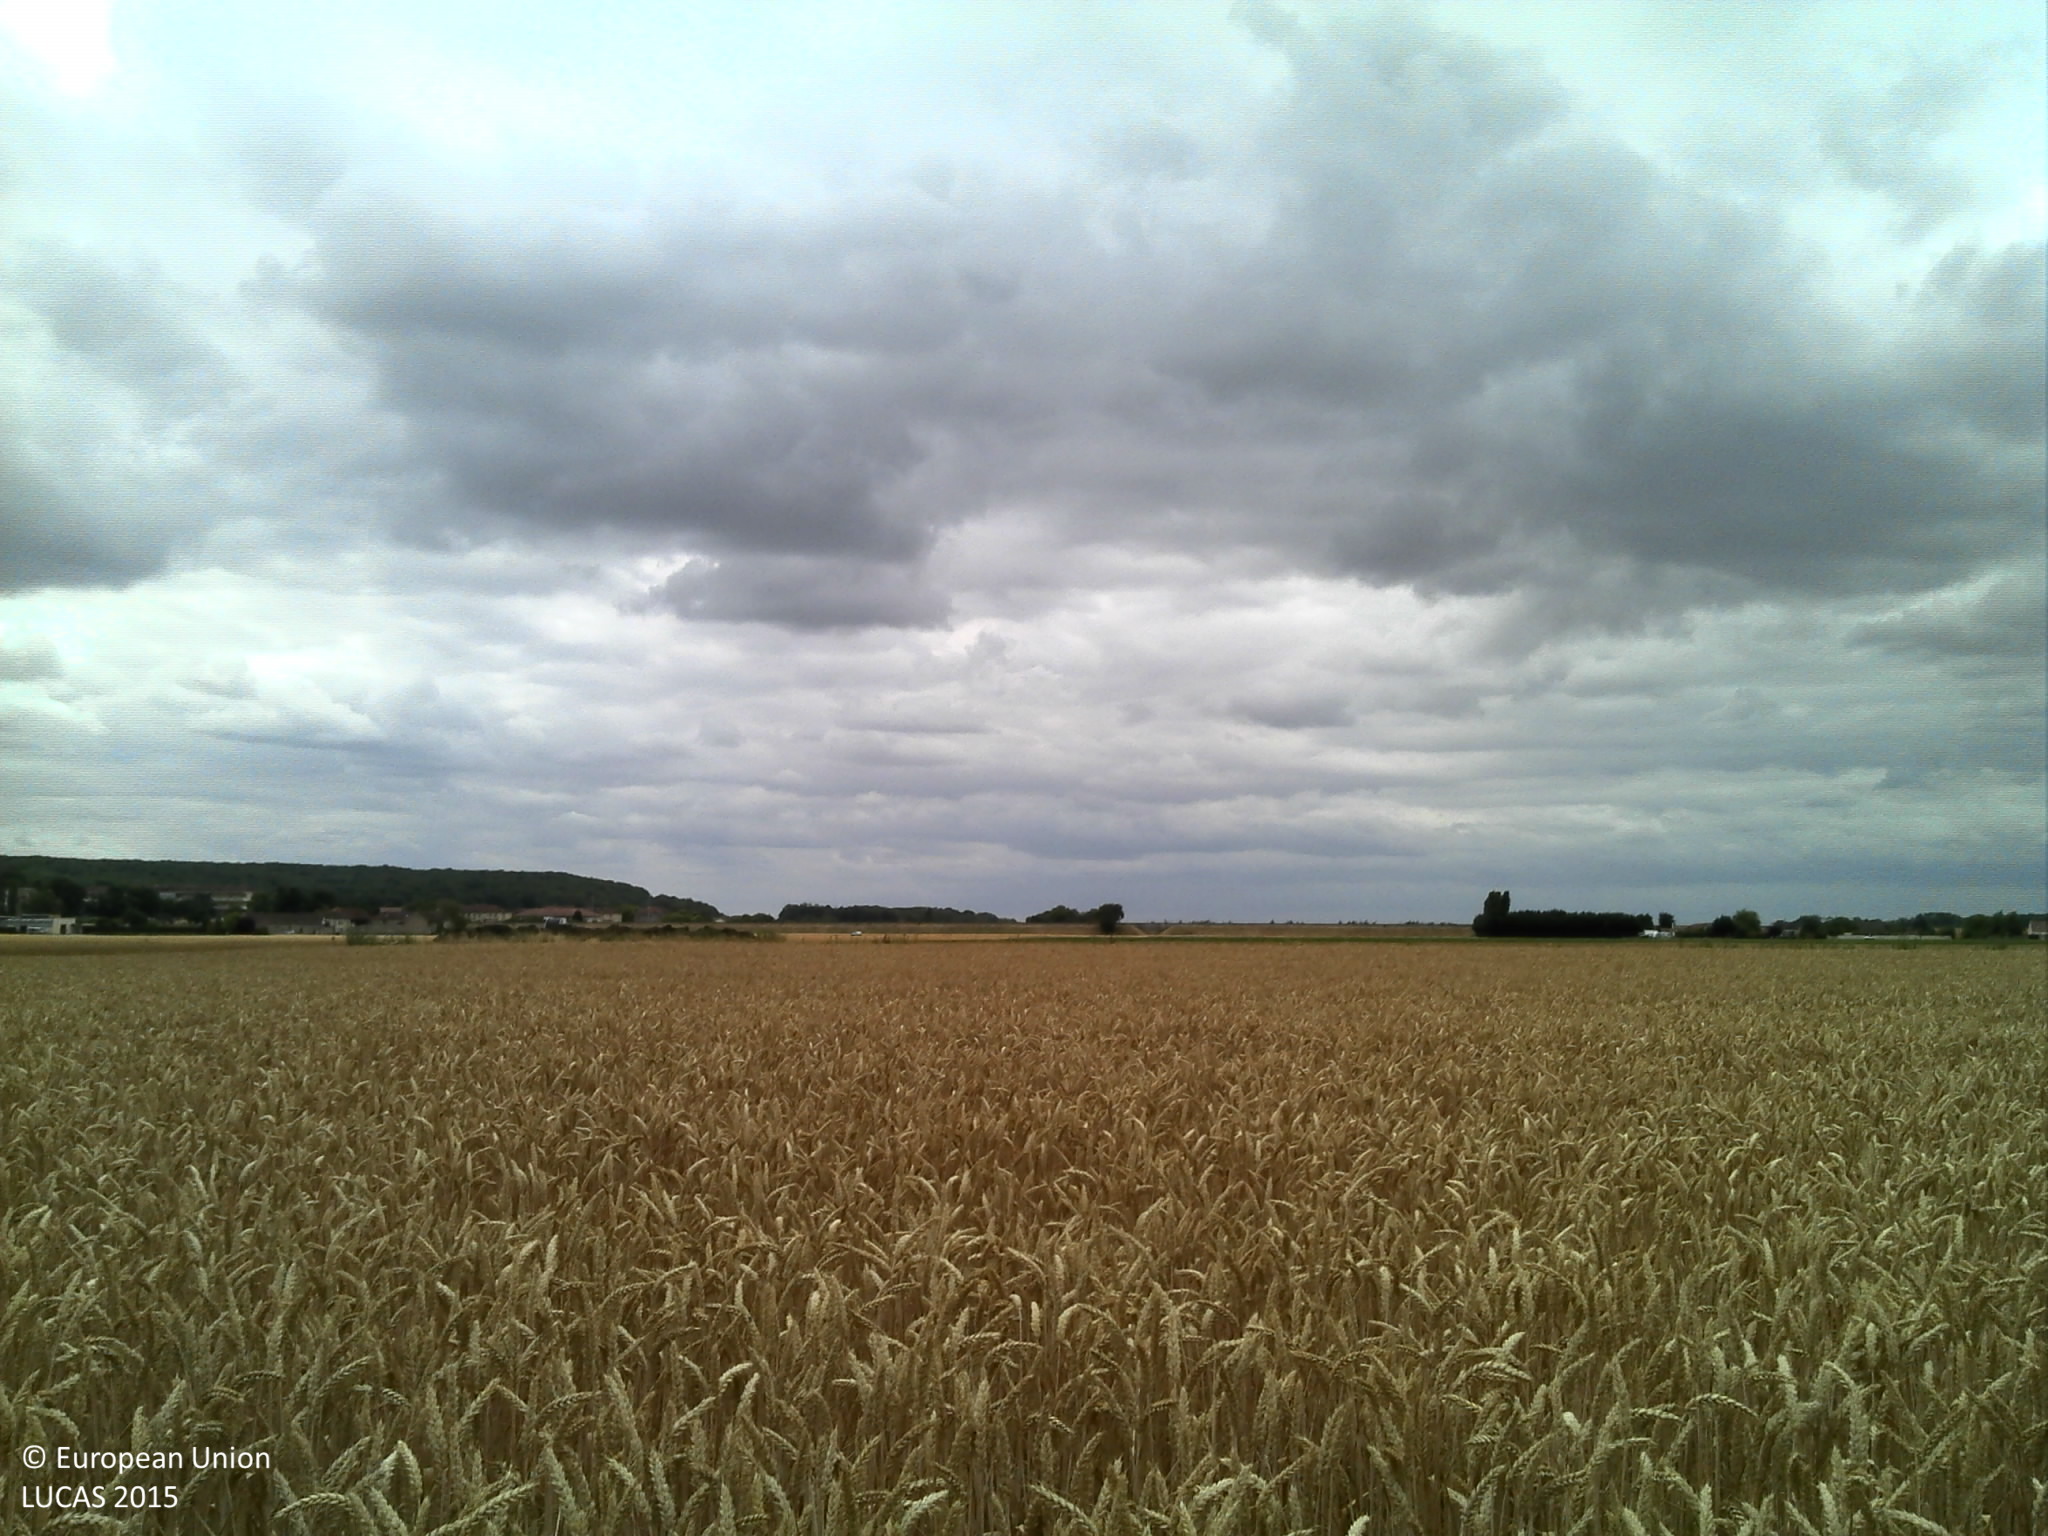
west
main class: Cropland
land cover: Common wheat
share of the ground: > 75 %
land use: Agriculture (excluding fallow land and kitchen gardens)
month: July
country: FR
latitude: 48.5245
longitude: 2.4471
